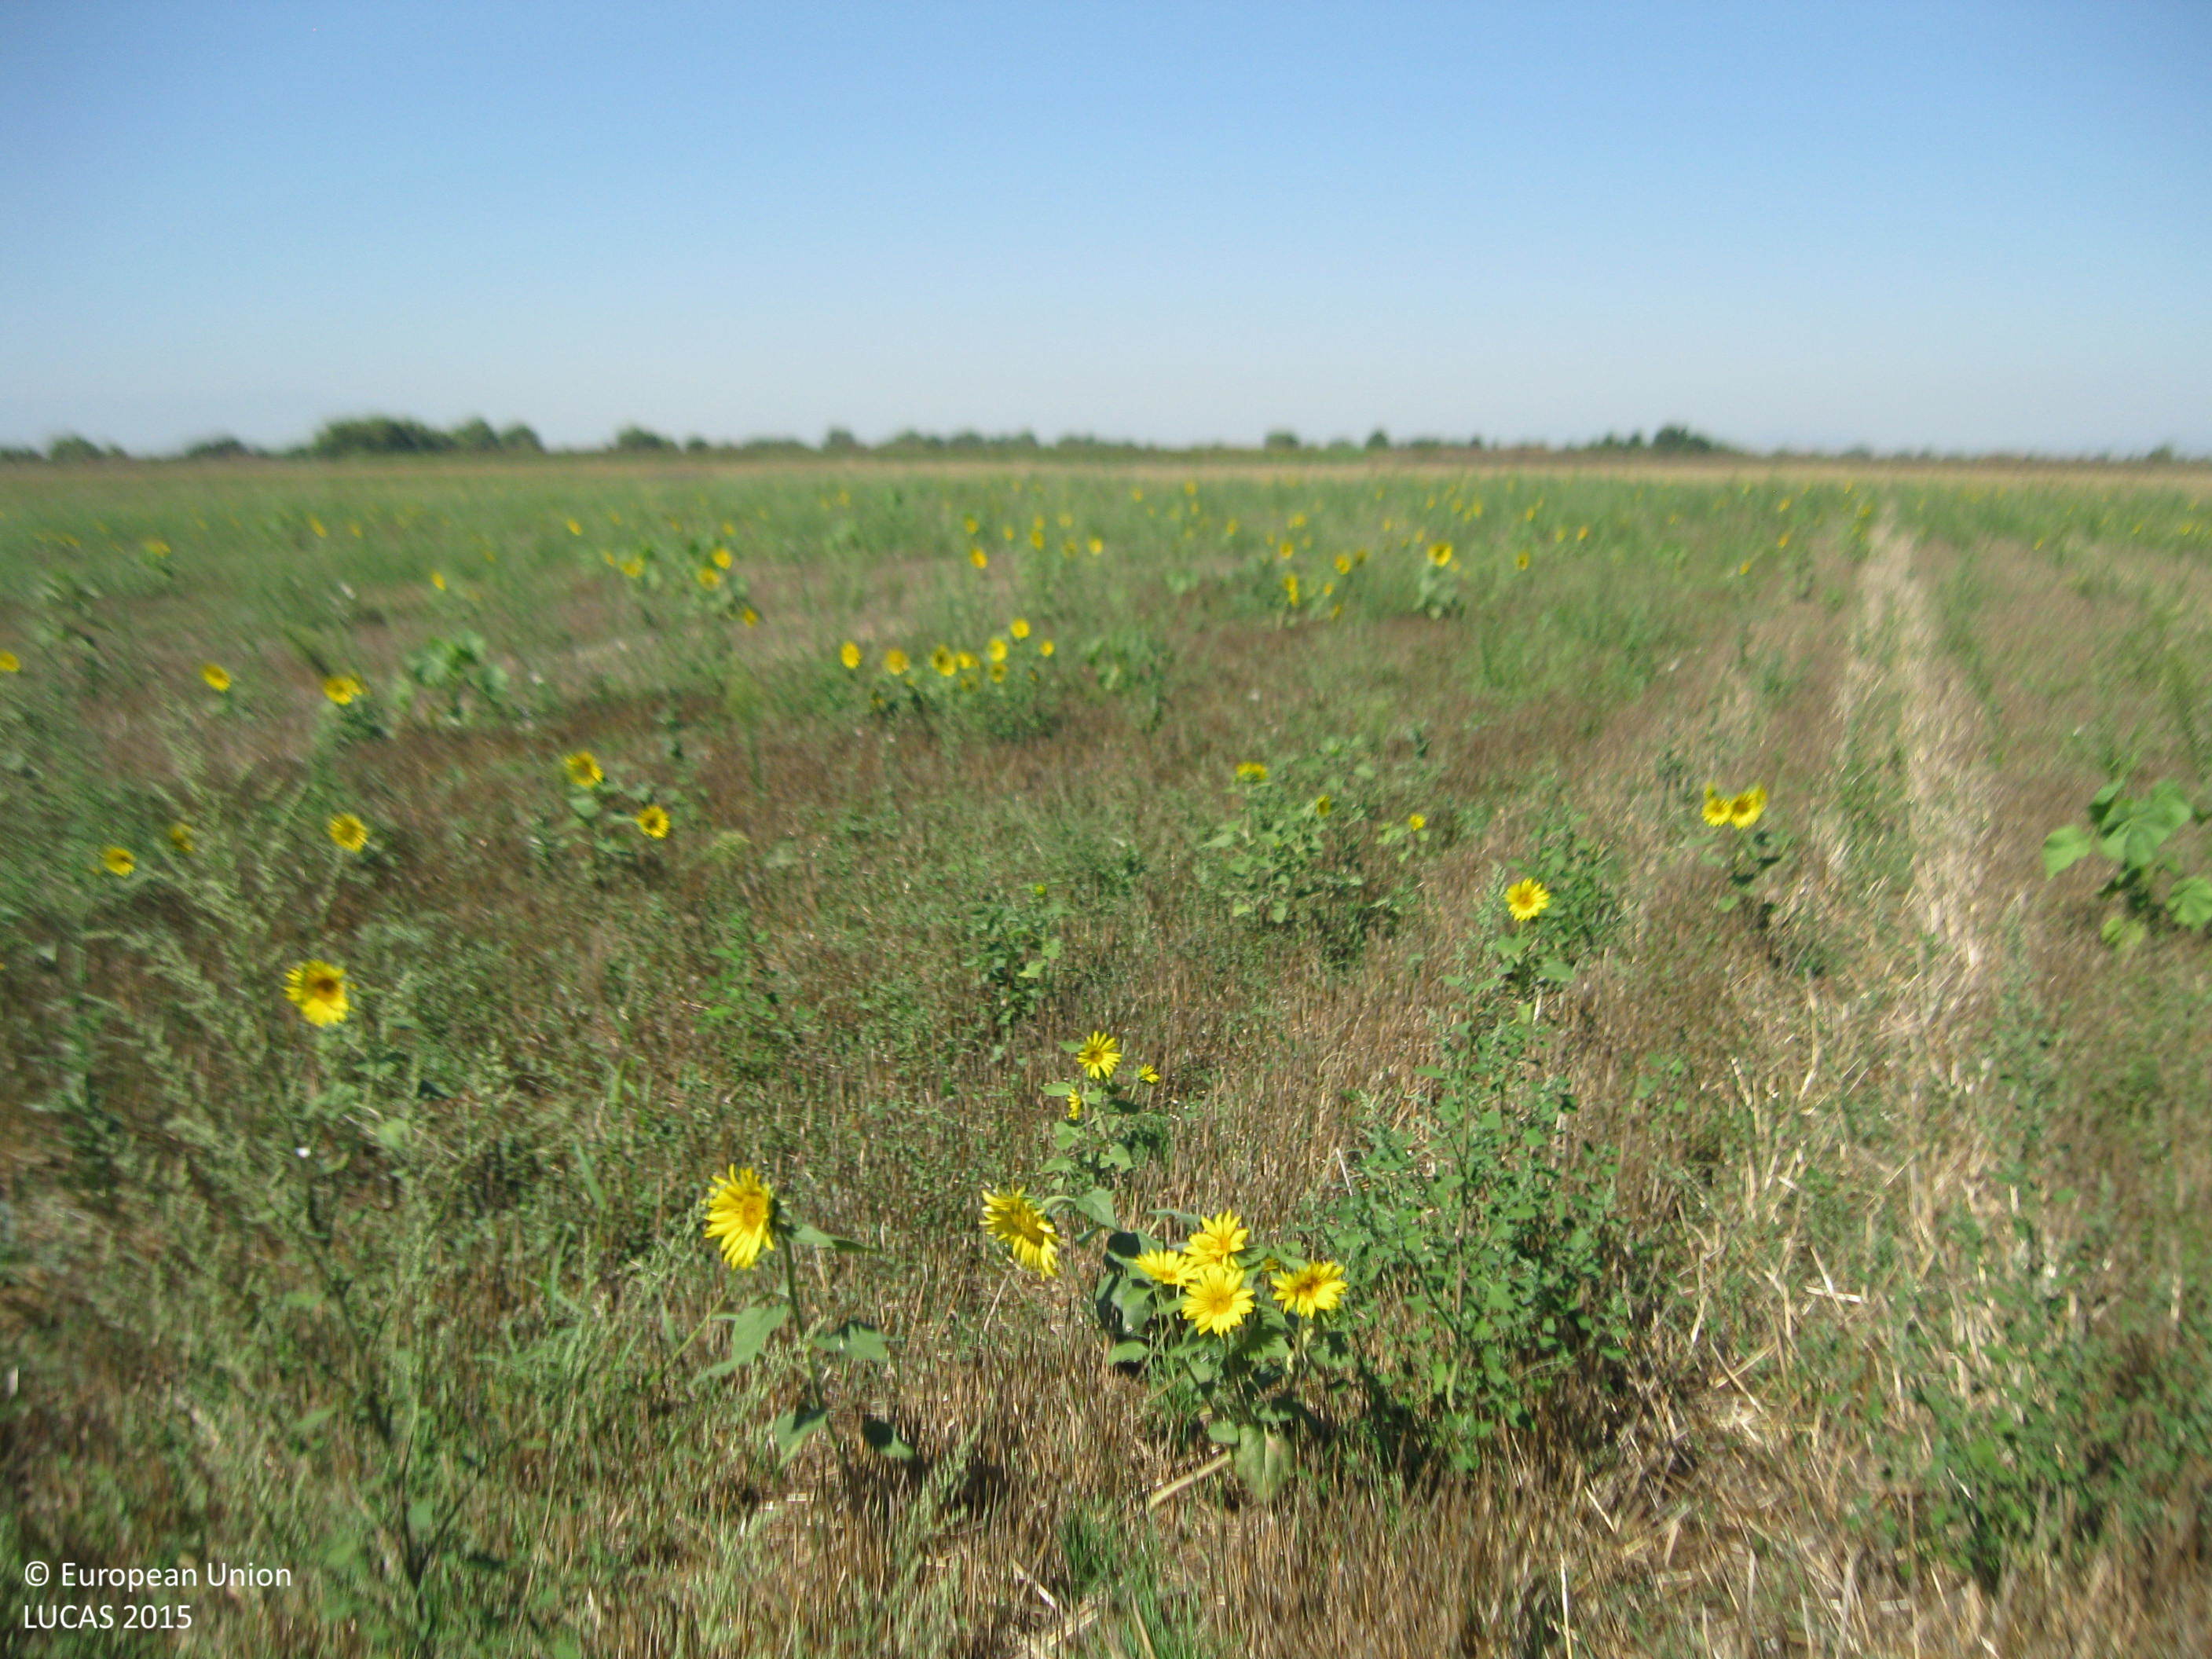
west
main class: Cropland
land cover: Common wheat
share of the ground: 25 - 50 %
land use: Agriculture (excluding fallow land and kitchen gardens)
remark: Harvested field
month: September
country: BG
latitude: 42.2094
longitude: 24.6214
